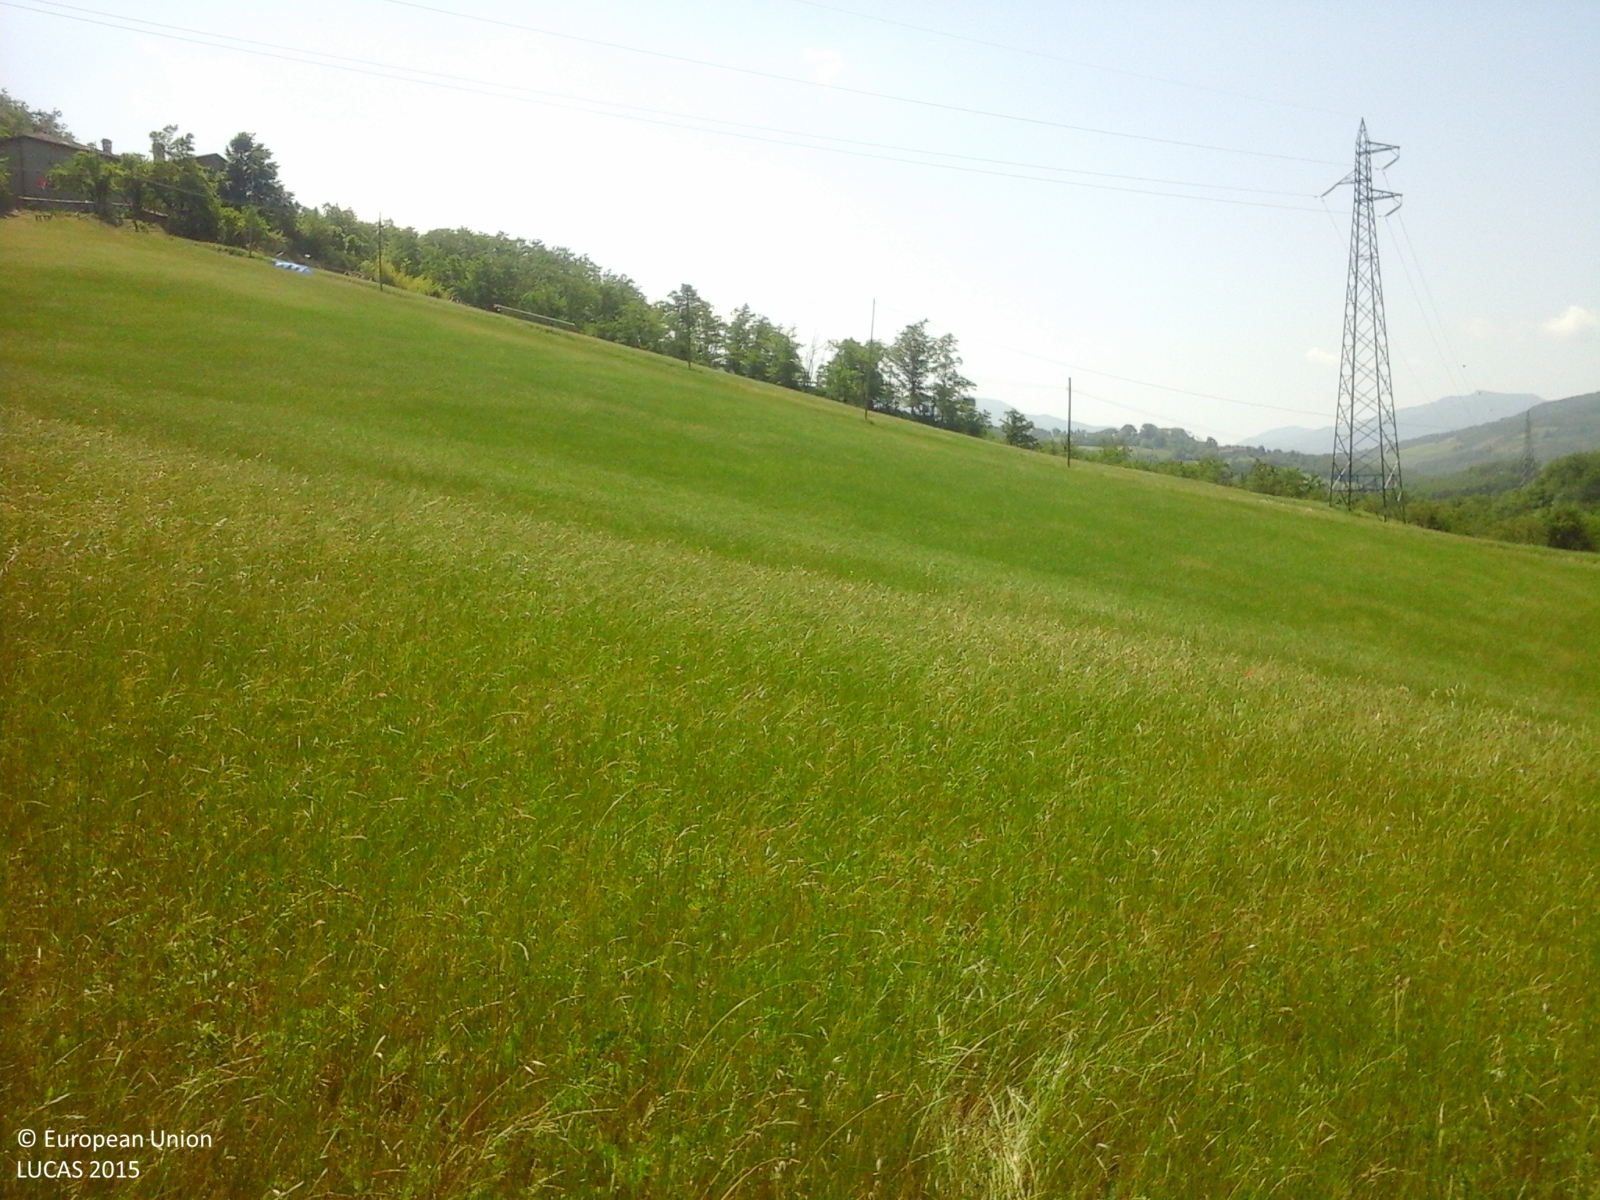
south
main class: Grassland
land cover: Grassland without tree/shrub cover
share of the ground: > 75 %
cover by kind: herbaceous plants 100 %
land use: Agriculture (excluding fallow land and kitchen gardens)
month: May
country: IT
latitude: 44.2189
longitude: 11.0614
